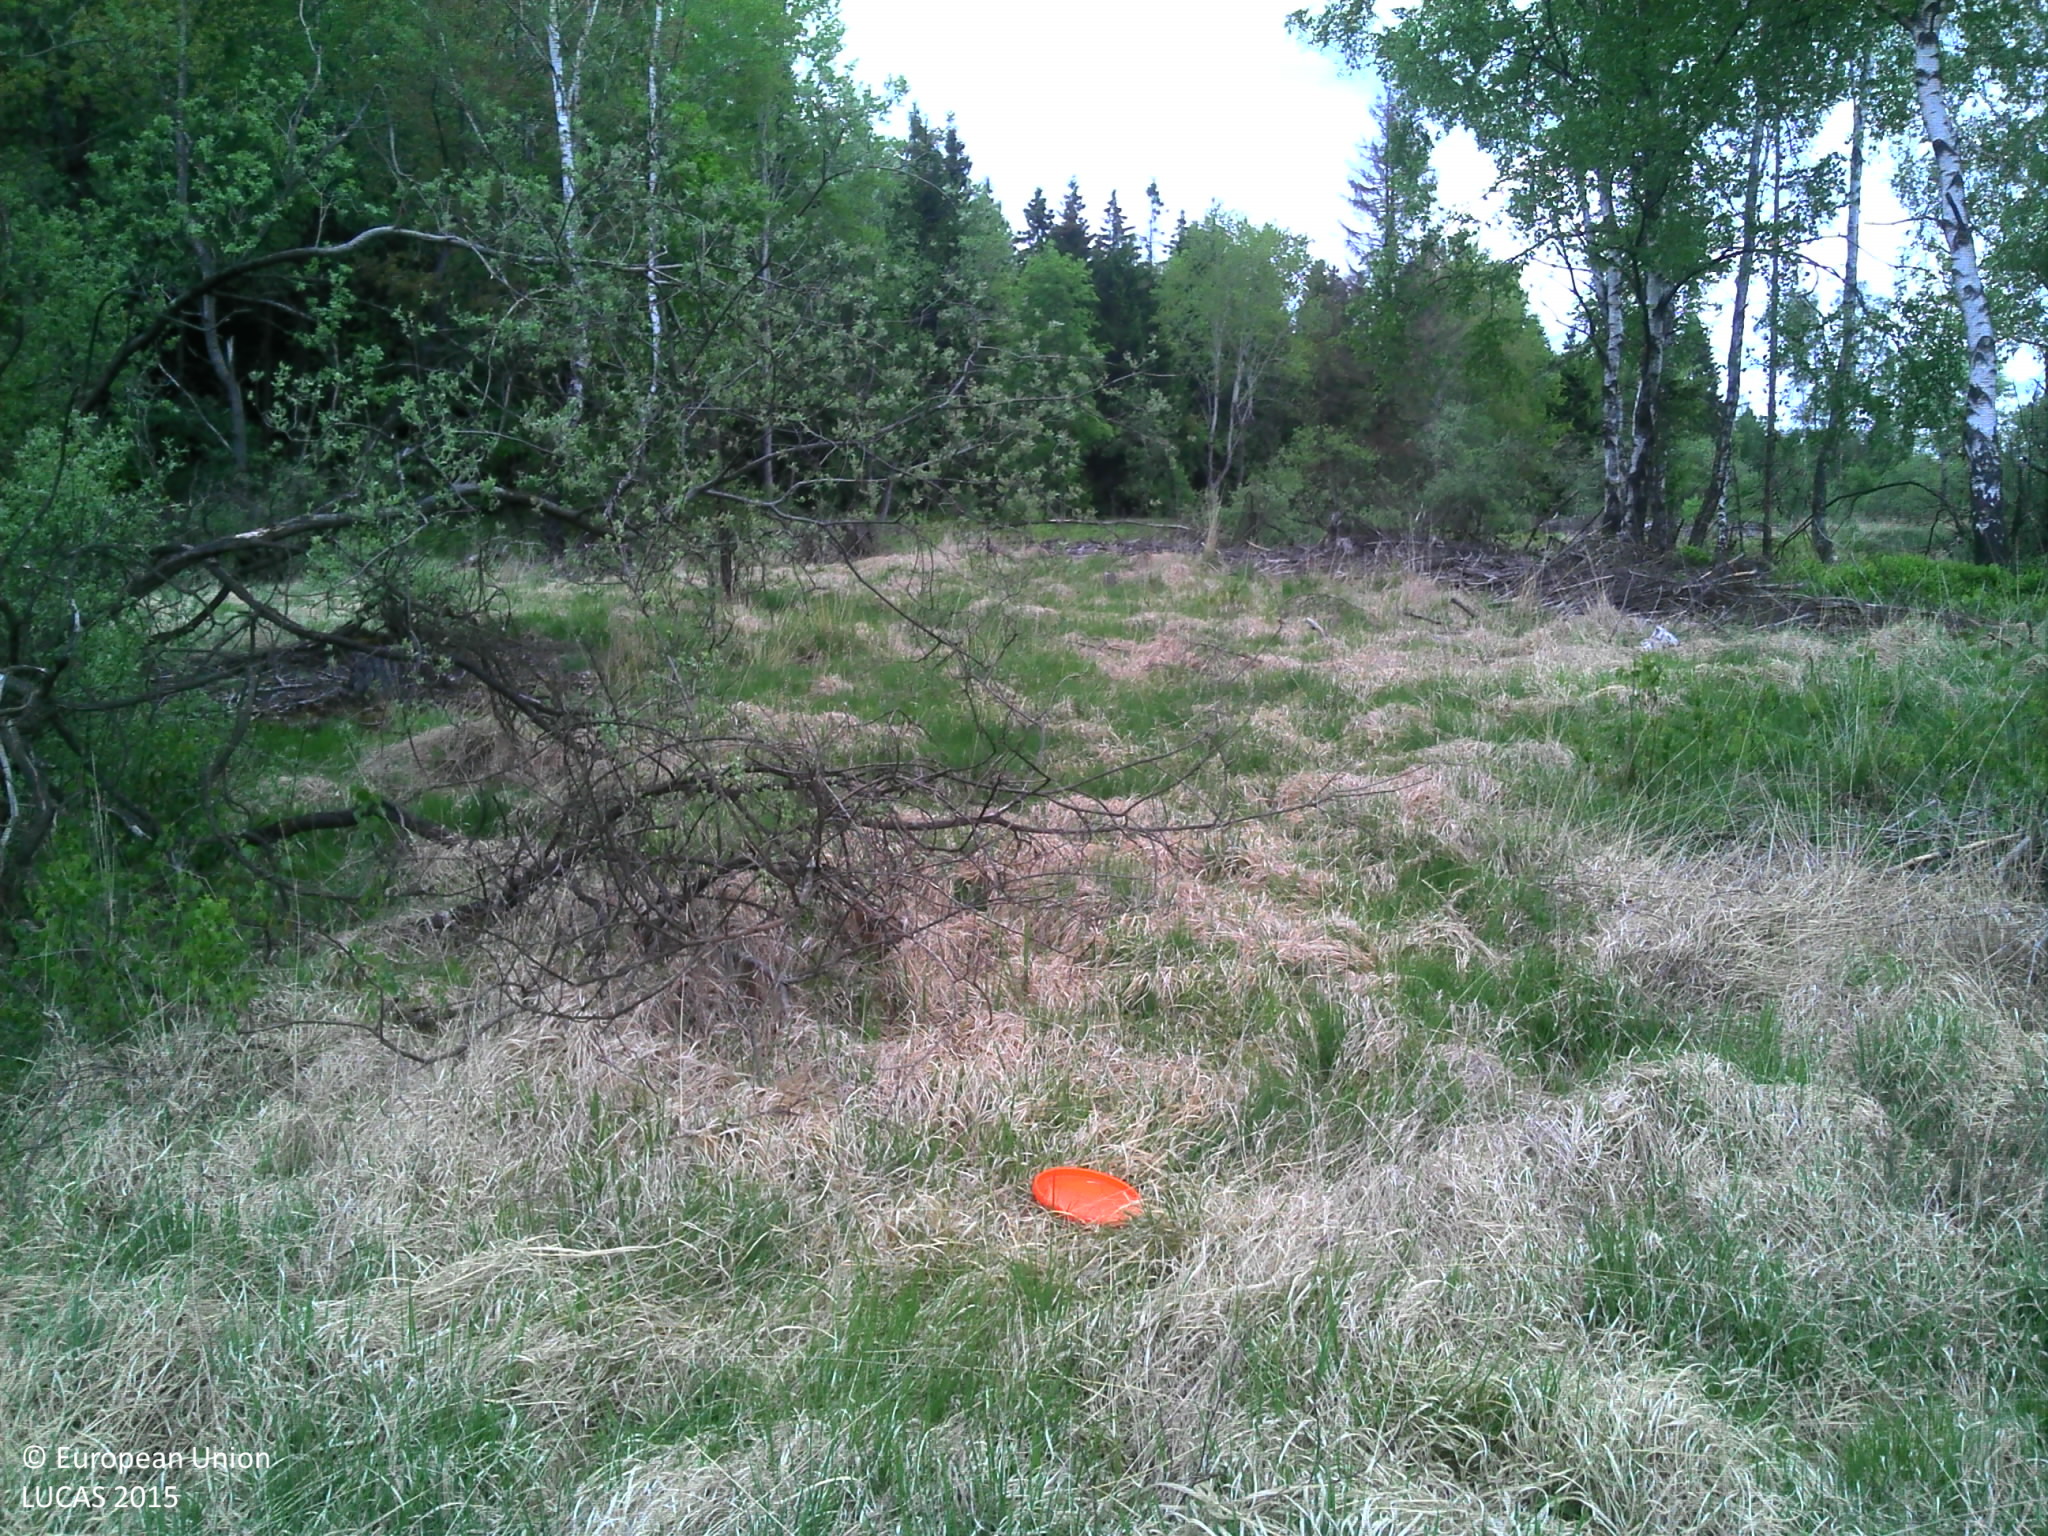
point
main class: Shrubland
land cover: Shrubland with sparse tree cover
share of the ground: > 75 %
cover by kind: herbaceous plants 80 %, shrubs 15 %, broadleaved forest trees 5 %
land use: Forestry
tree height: > 5 m
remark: Temporary flooded
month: May
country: BE
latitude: 50.6088
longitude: 6.2546
